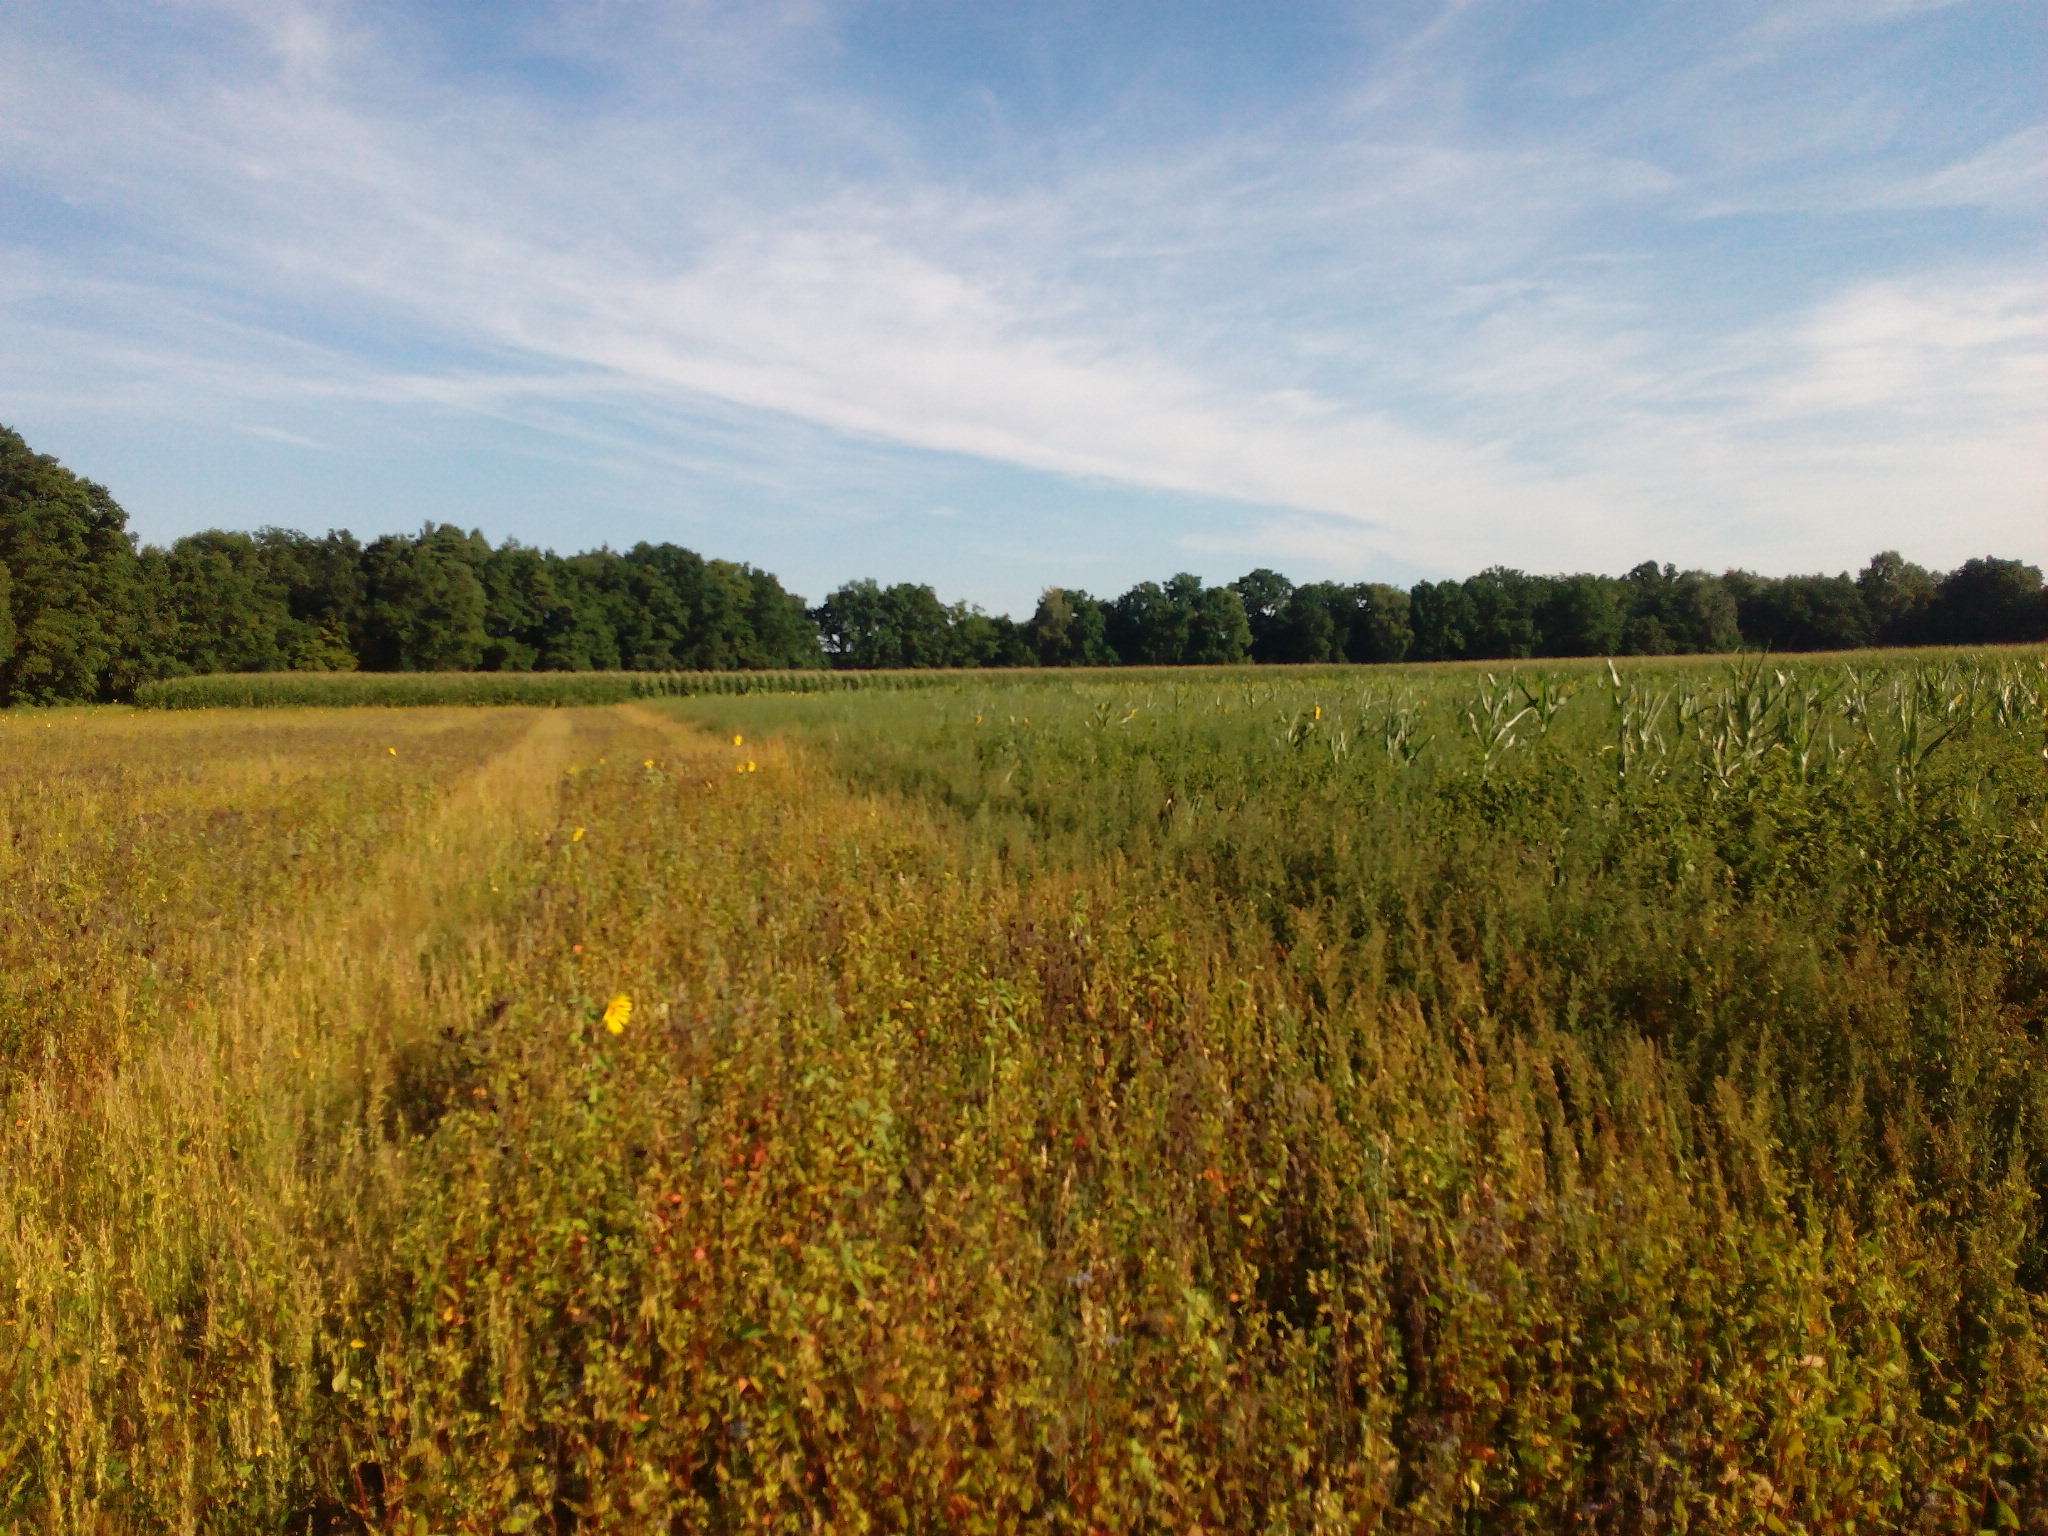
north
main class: Cropland
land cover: Lucerne
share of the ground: > 75 %
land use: Agriculture (excluding fallow land and kitchen gardens)
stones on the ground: < 10 %
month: August
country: DE
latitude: 52.5571
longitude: 9.8673
